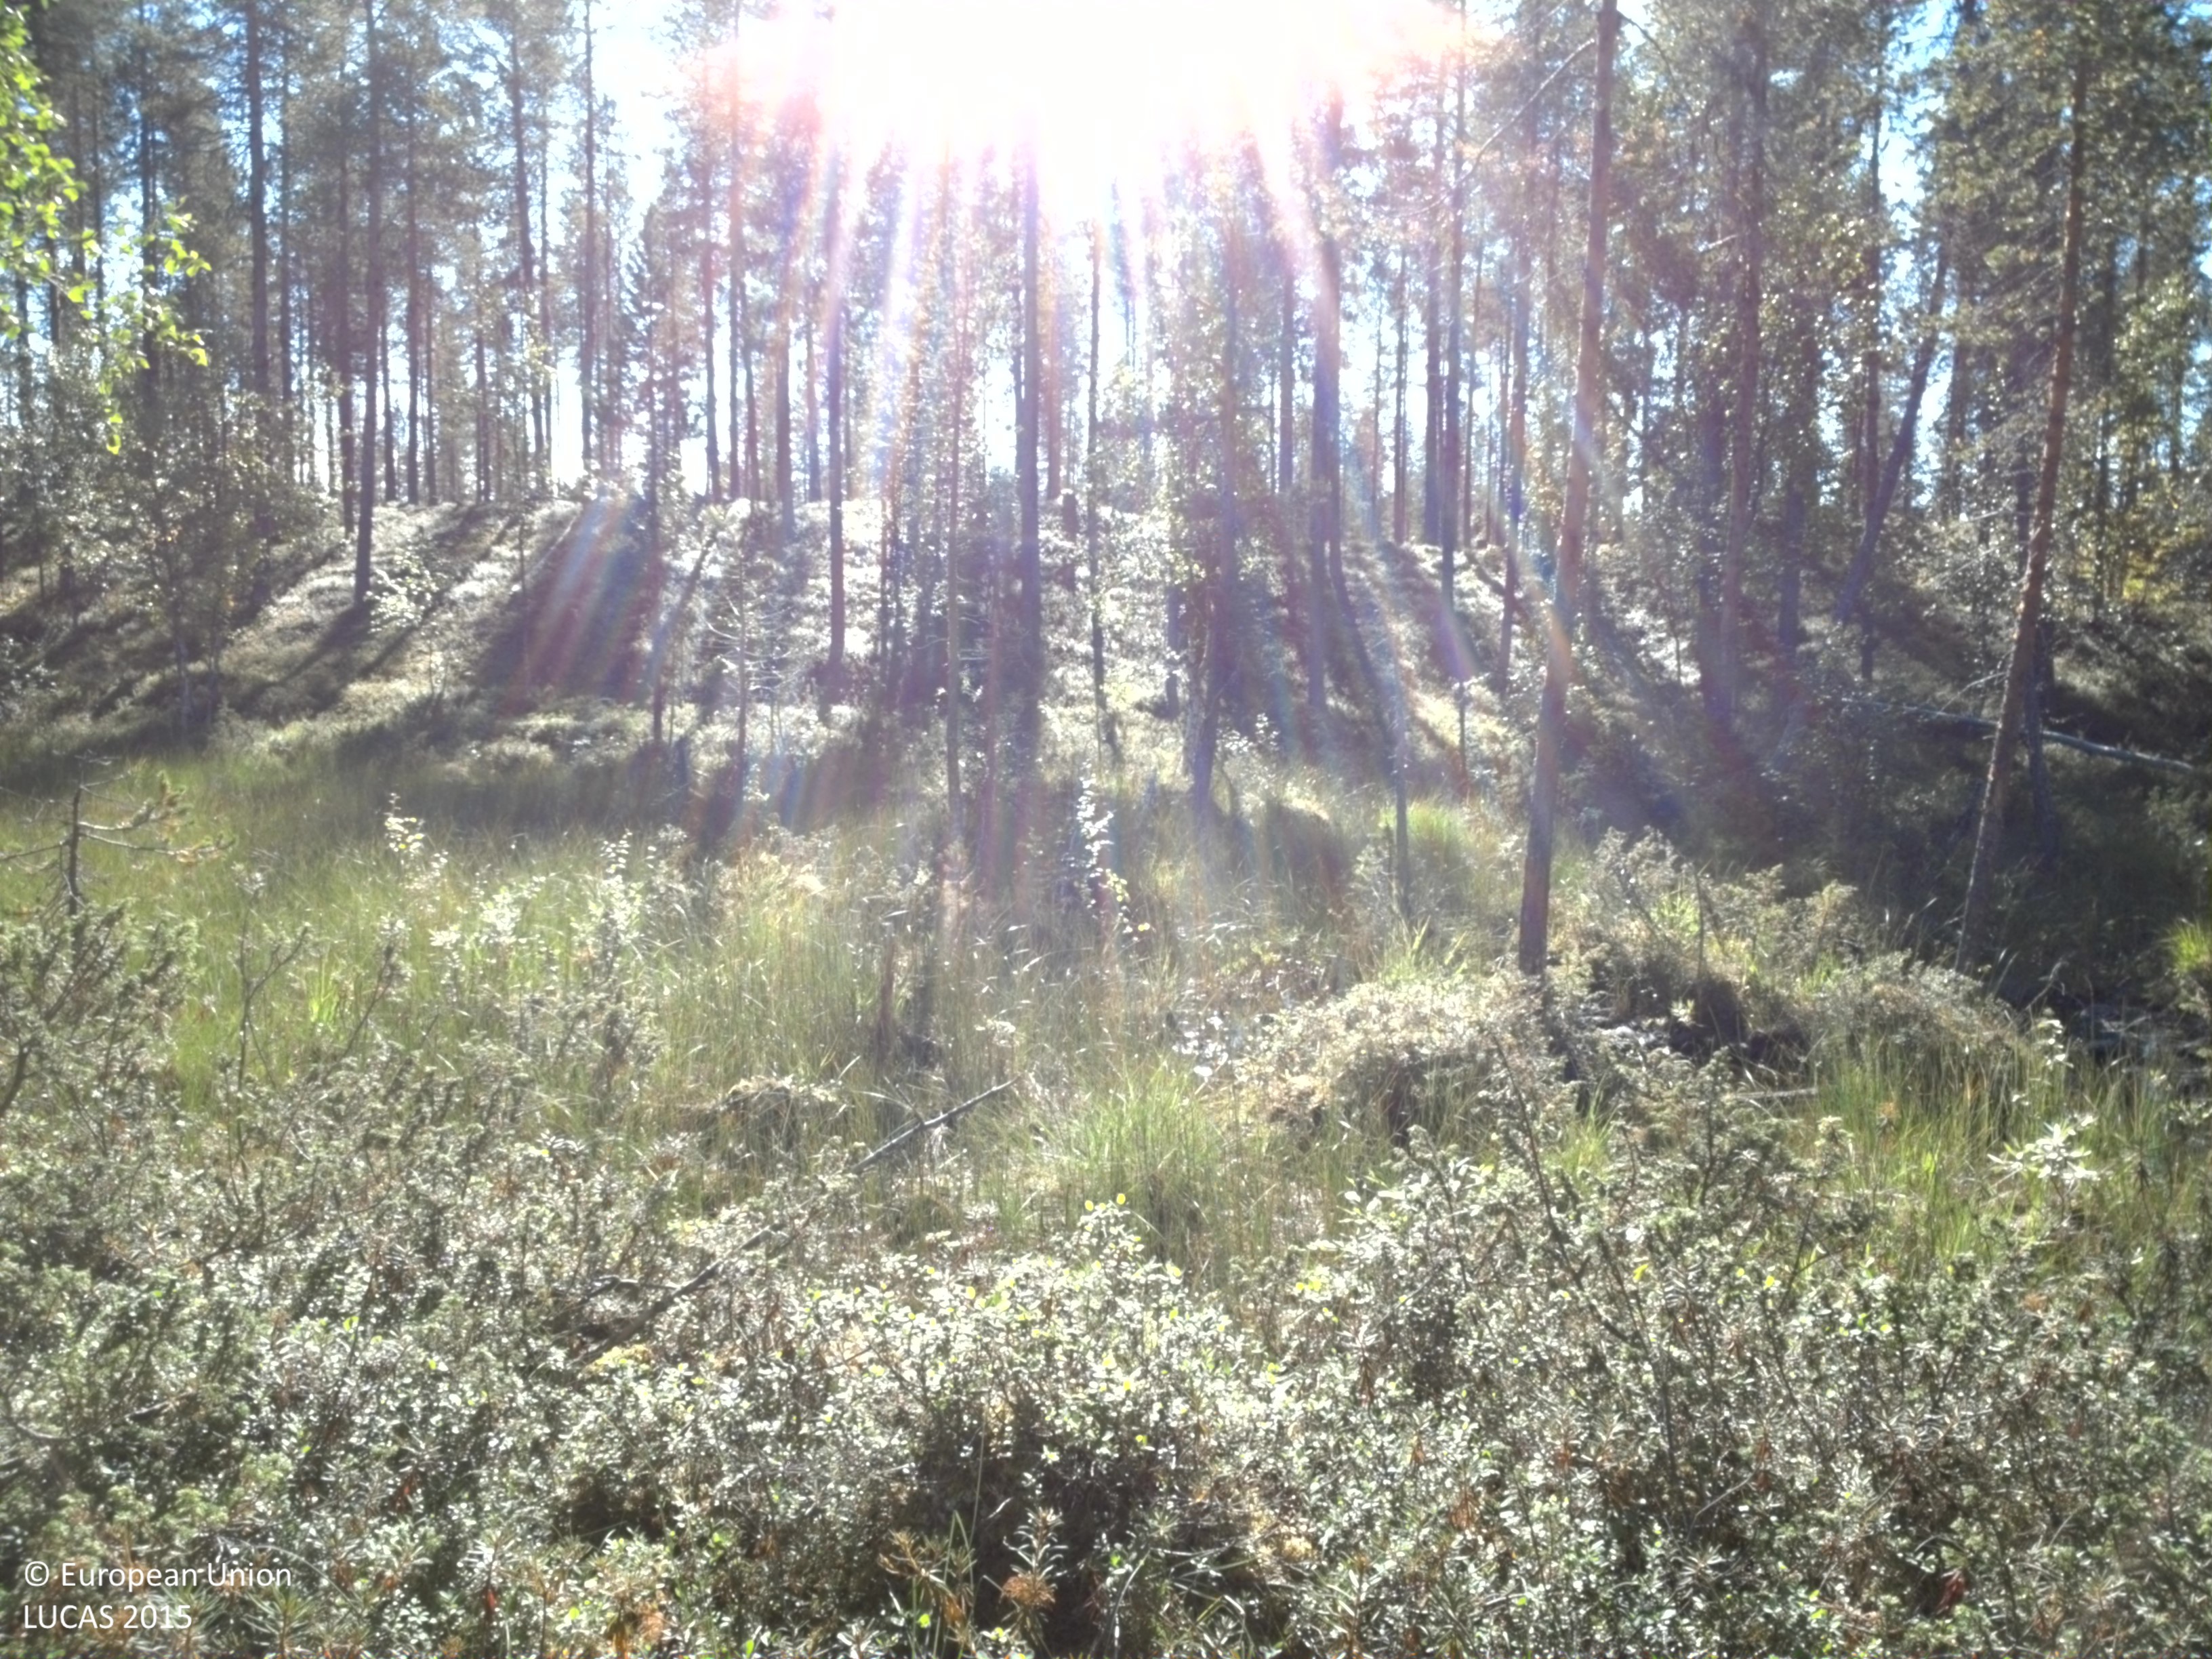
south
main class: Woodland
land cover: Pine dominated coniferous woodland
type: boreal forest
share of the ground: 25 - 50 %
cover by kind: shrubs 70 %, coniferous forest trees 30 %
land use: Forestry
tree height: > 5 m
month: August
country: SE
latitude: 66.8295
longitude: 19.1724
